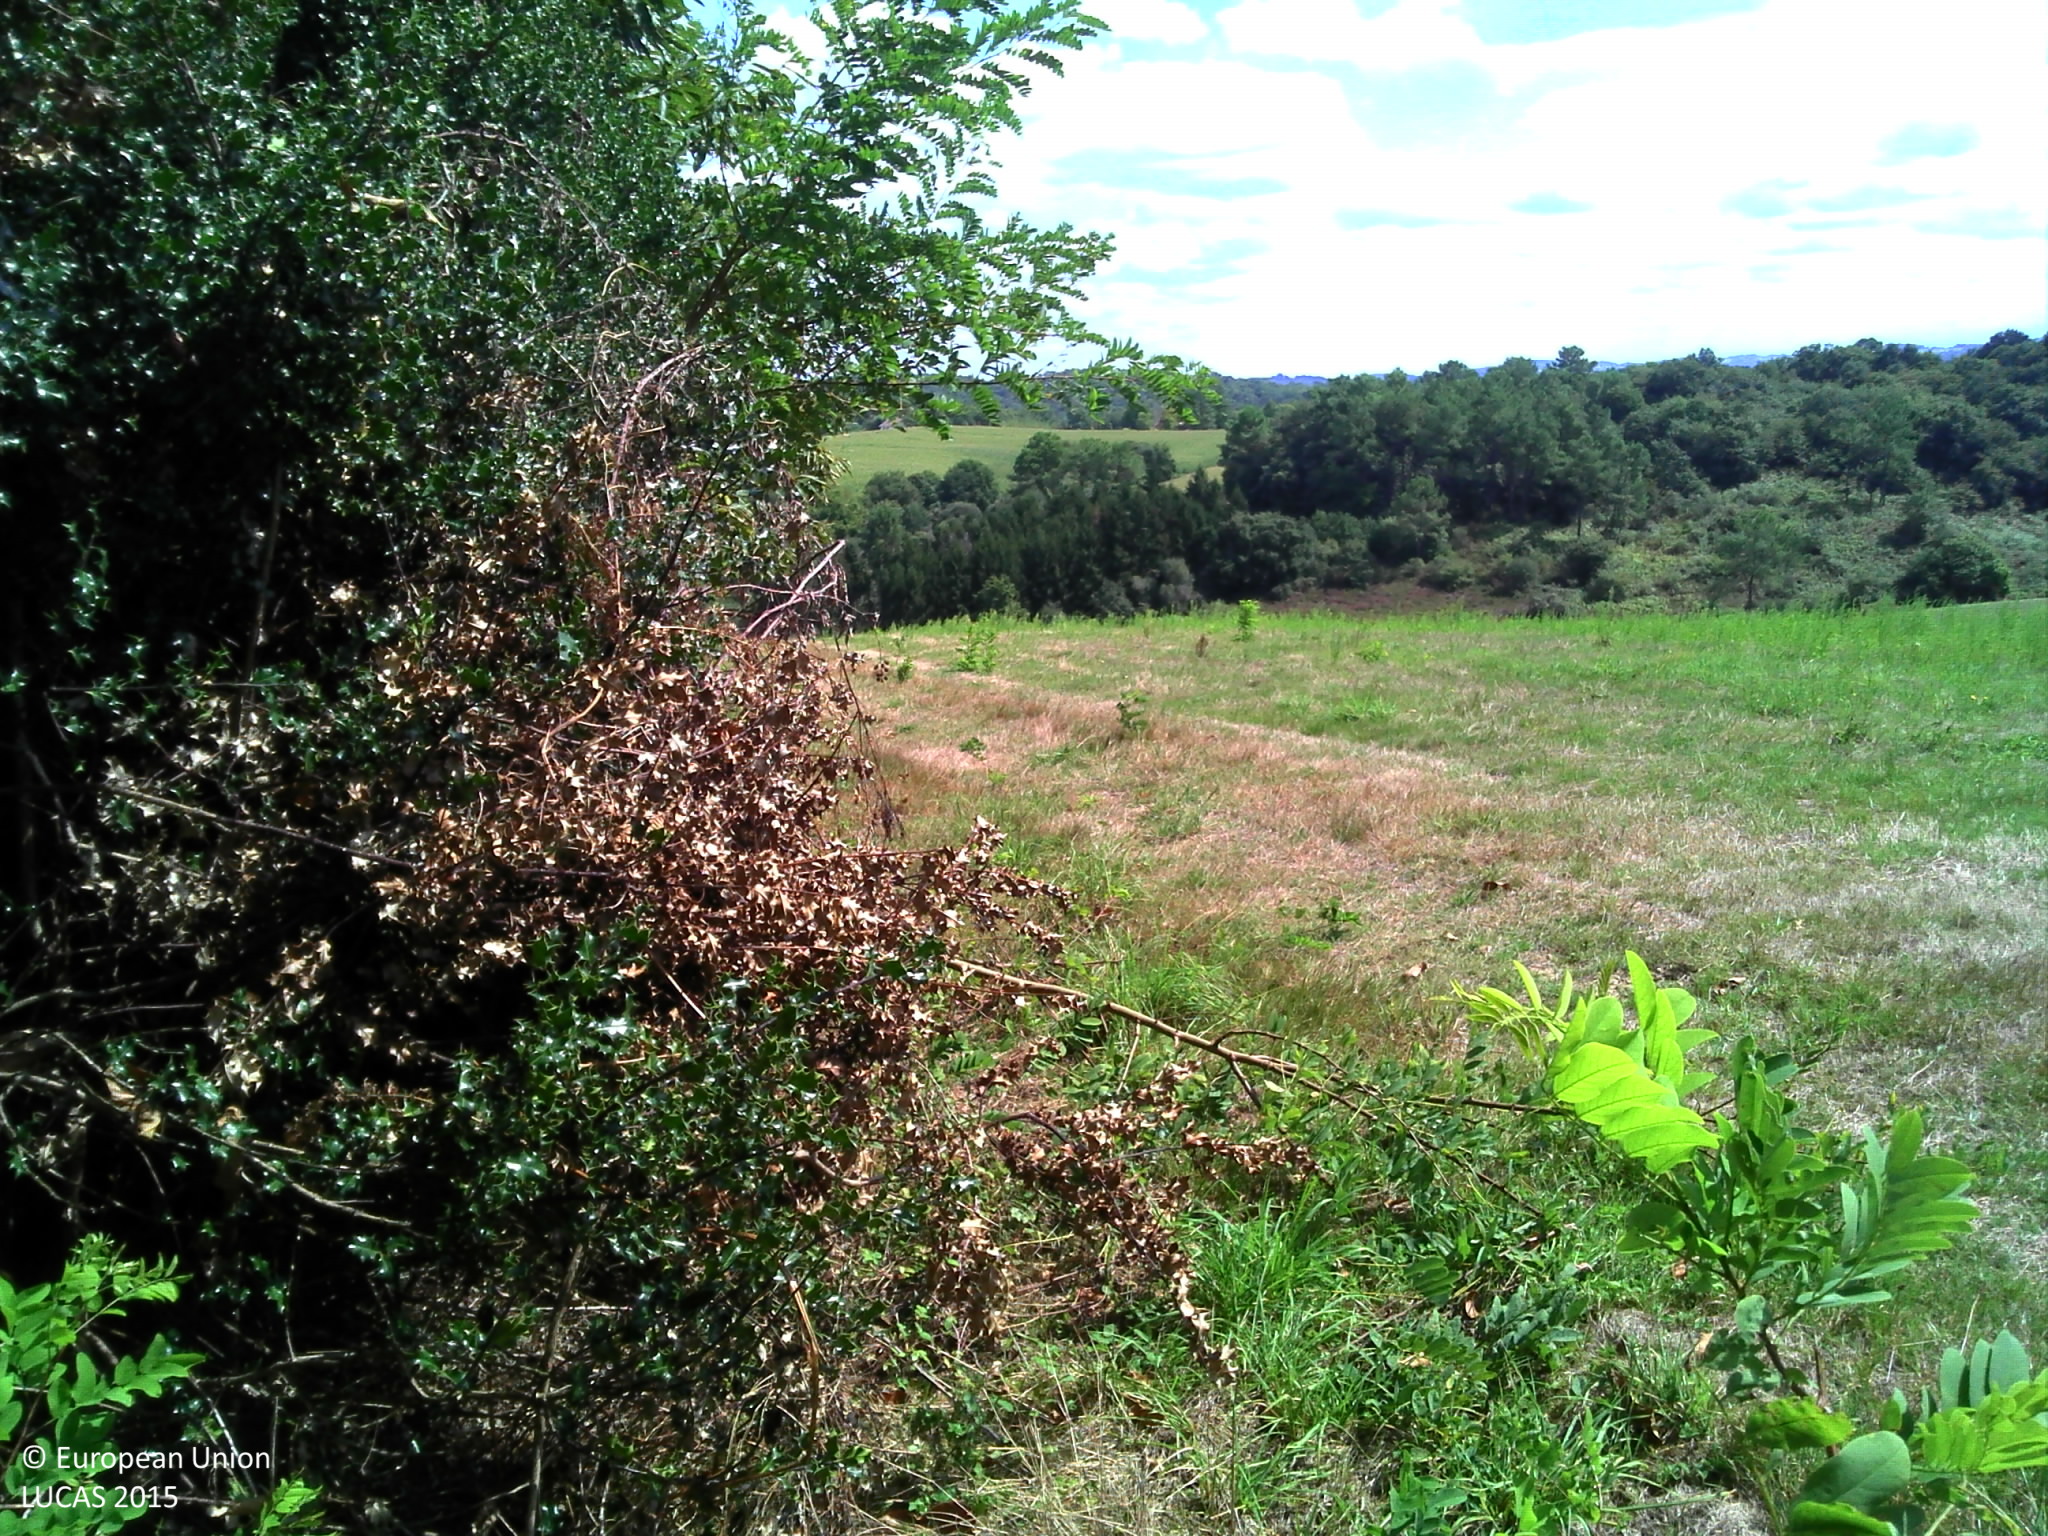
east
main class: Woodland
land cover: Broadleaved woodland
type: acidophilous oak and oak-birch forest
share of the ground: > 75 %
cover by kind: broadleaved forest trees 75 %, shrubs 10 %, herbaceous plants 10 %, lichens and mosses 5 %
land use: Forestry
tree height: > 5 m
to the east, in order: Broadleaved woodland; Grassland without tree/shrub cover; Spontaneously vegetated surfaces; Ditches and canals; Maize; Grassland without tree/shrub cover
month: September
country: FR
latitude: 43.4956
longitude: -0.9577
